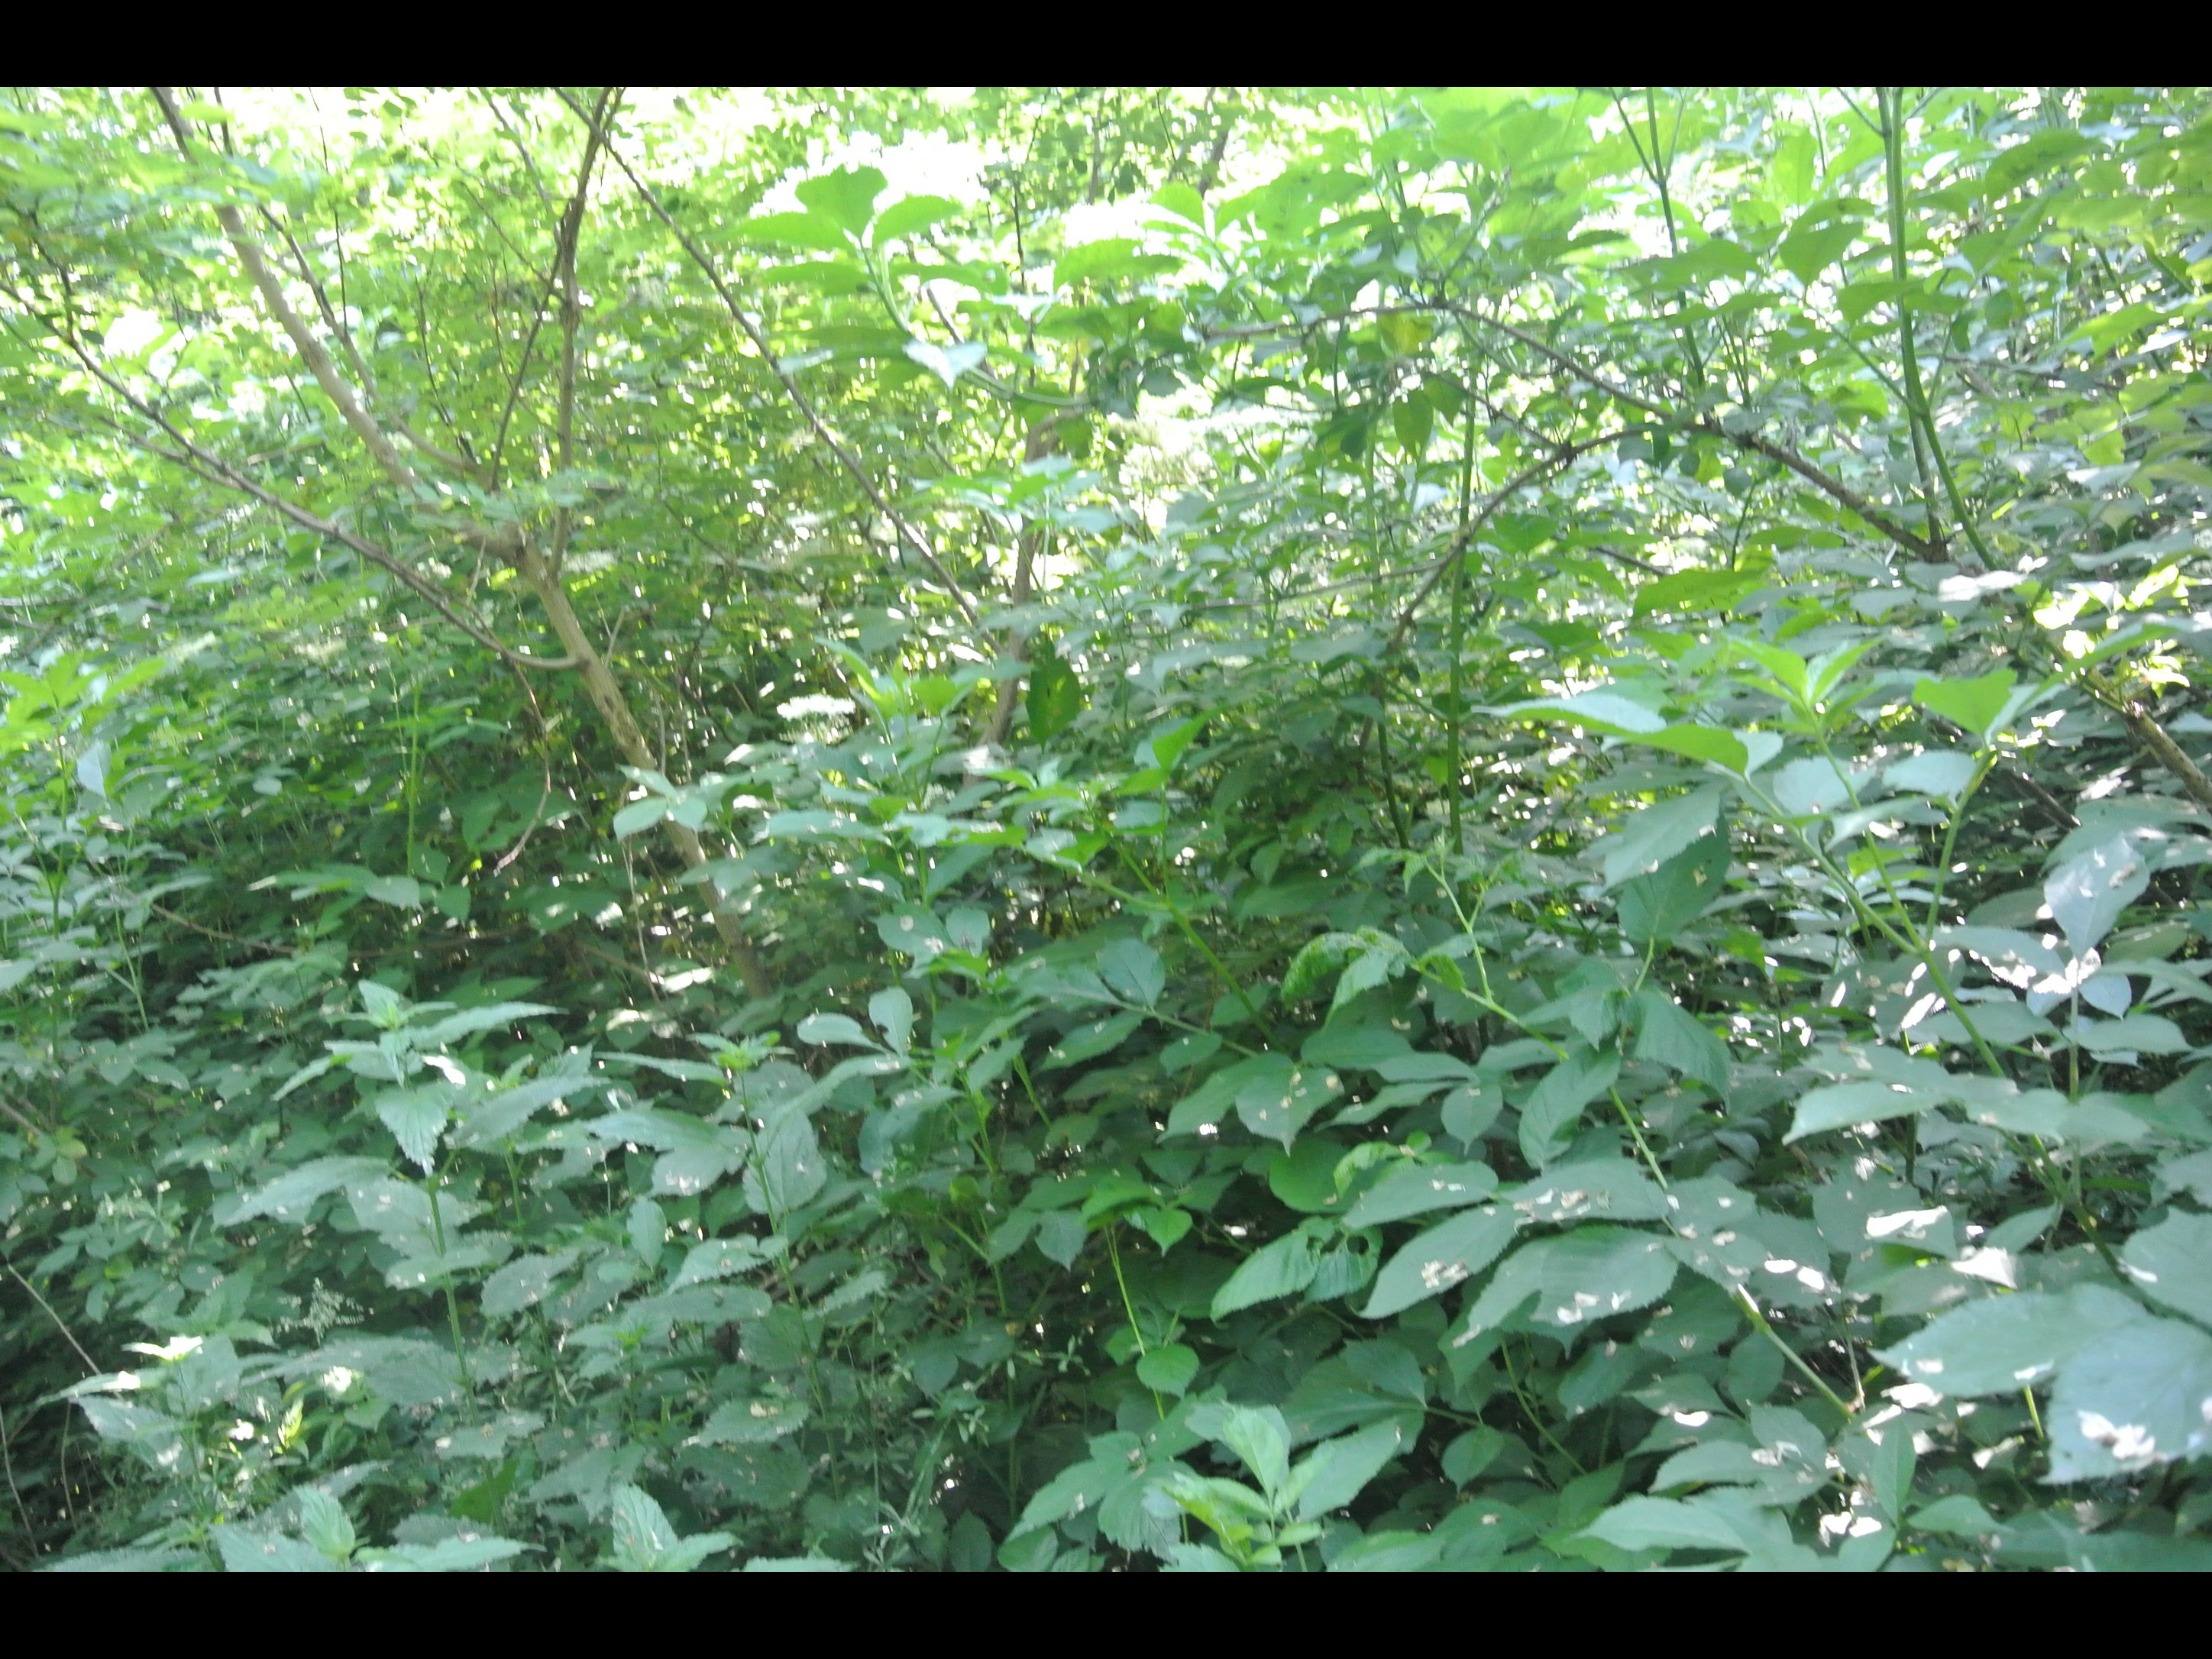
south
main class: Woodland
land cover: Broadleaved woodland
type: thermophilous deciduous forest
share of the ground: > 75 %
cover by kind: broadleaved forest trees 85 %, herbaceous plants 15 %
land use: Forestry
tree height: > 5 m
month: June
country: AT
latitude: 47.8667
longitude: 16.5420
